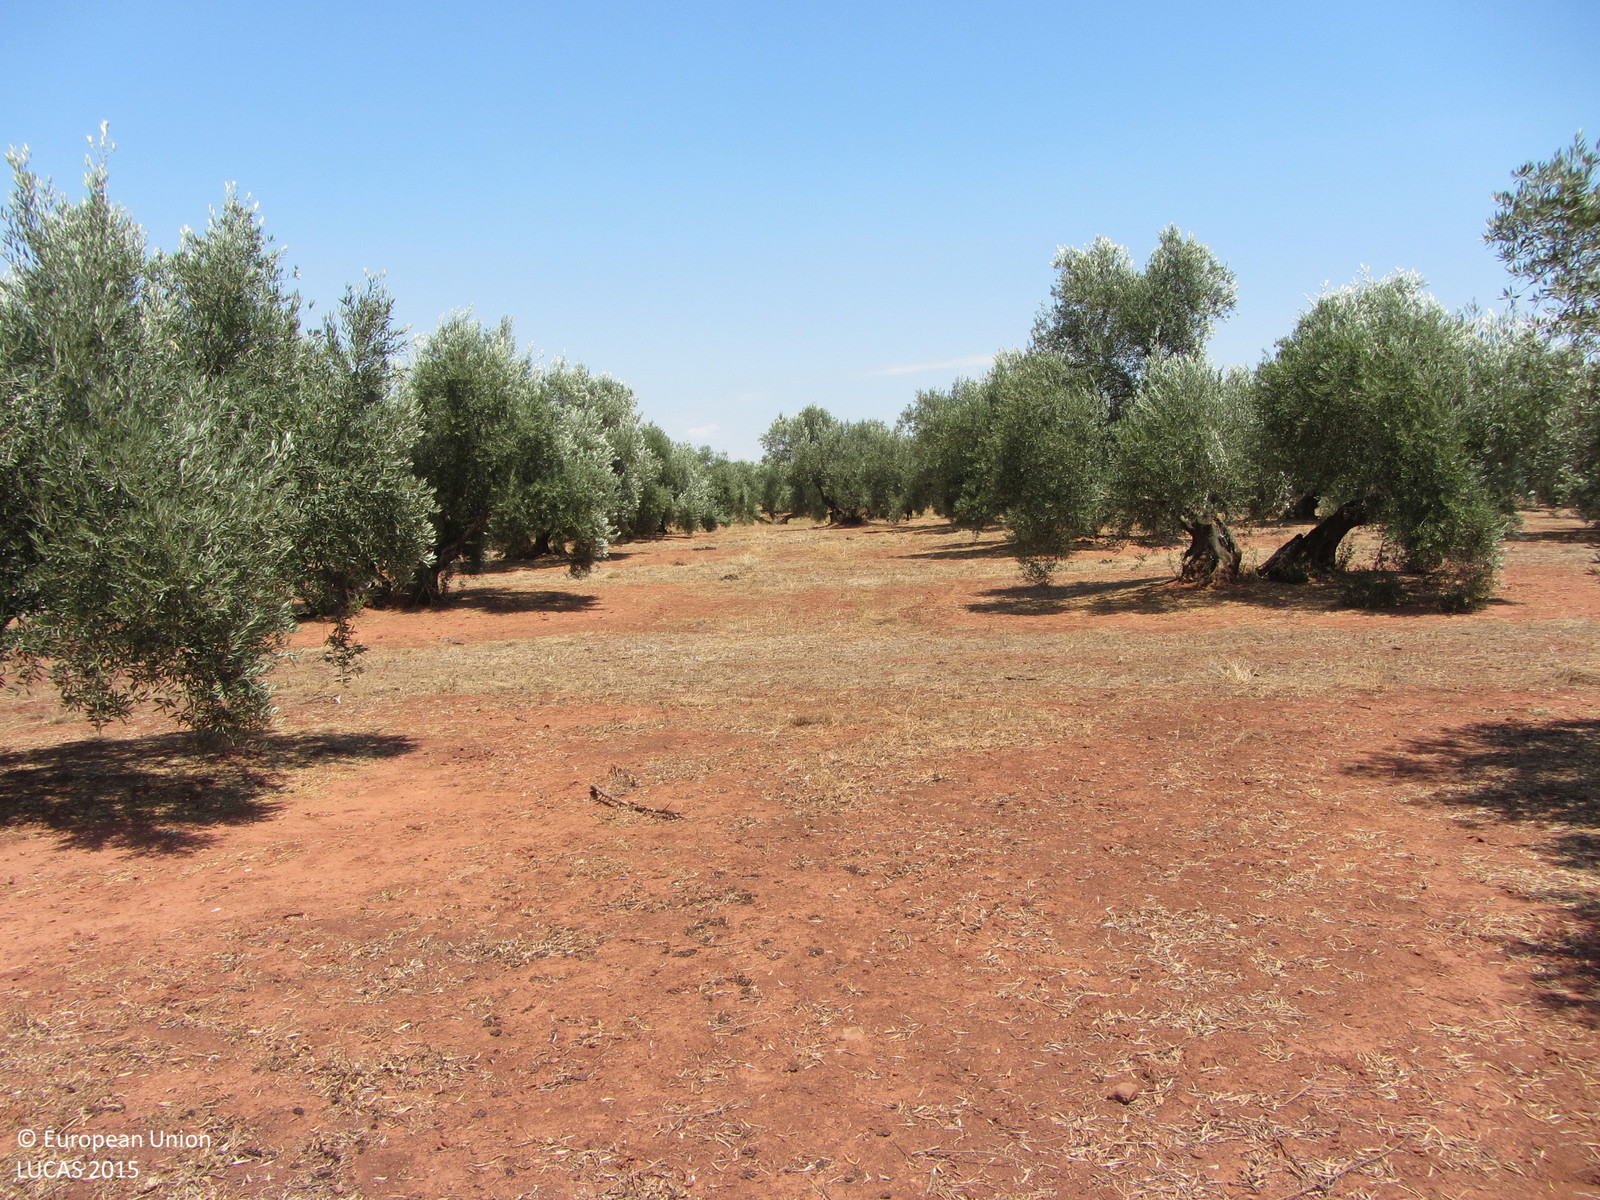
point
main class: Cropland
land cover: Olive groves
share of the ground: 25 - 50 %
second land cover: Other bare soil
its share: > 75 %
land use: Agriculture (excluding fallow land and kitchen gardens)
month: June
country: ES
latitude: 38.2011
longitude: -3.4440
